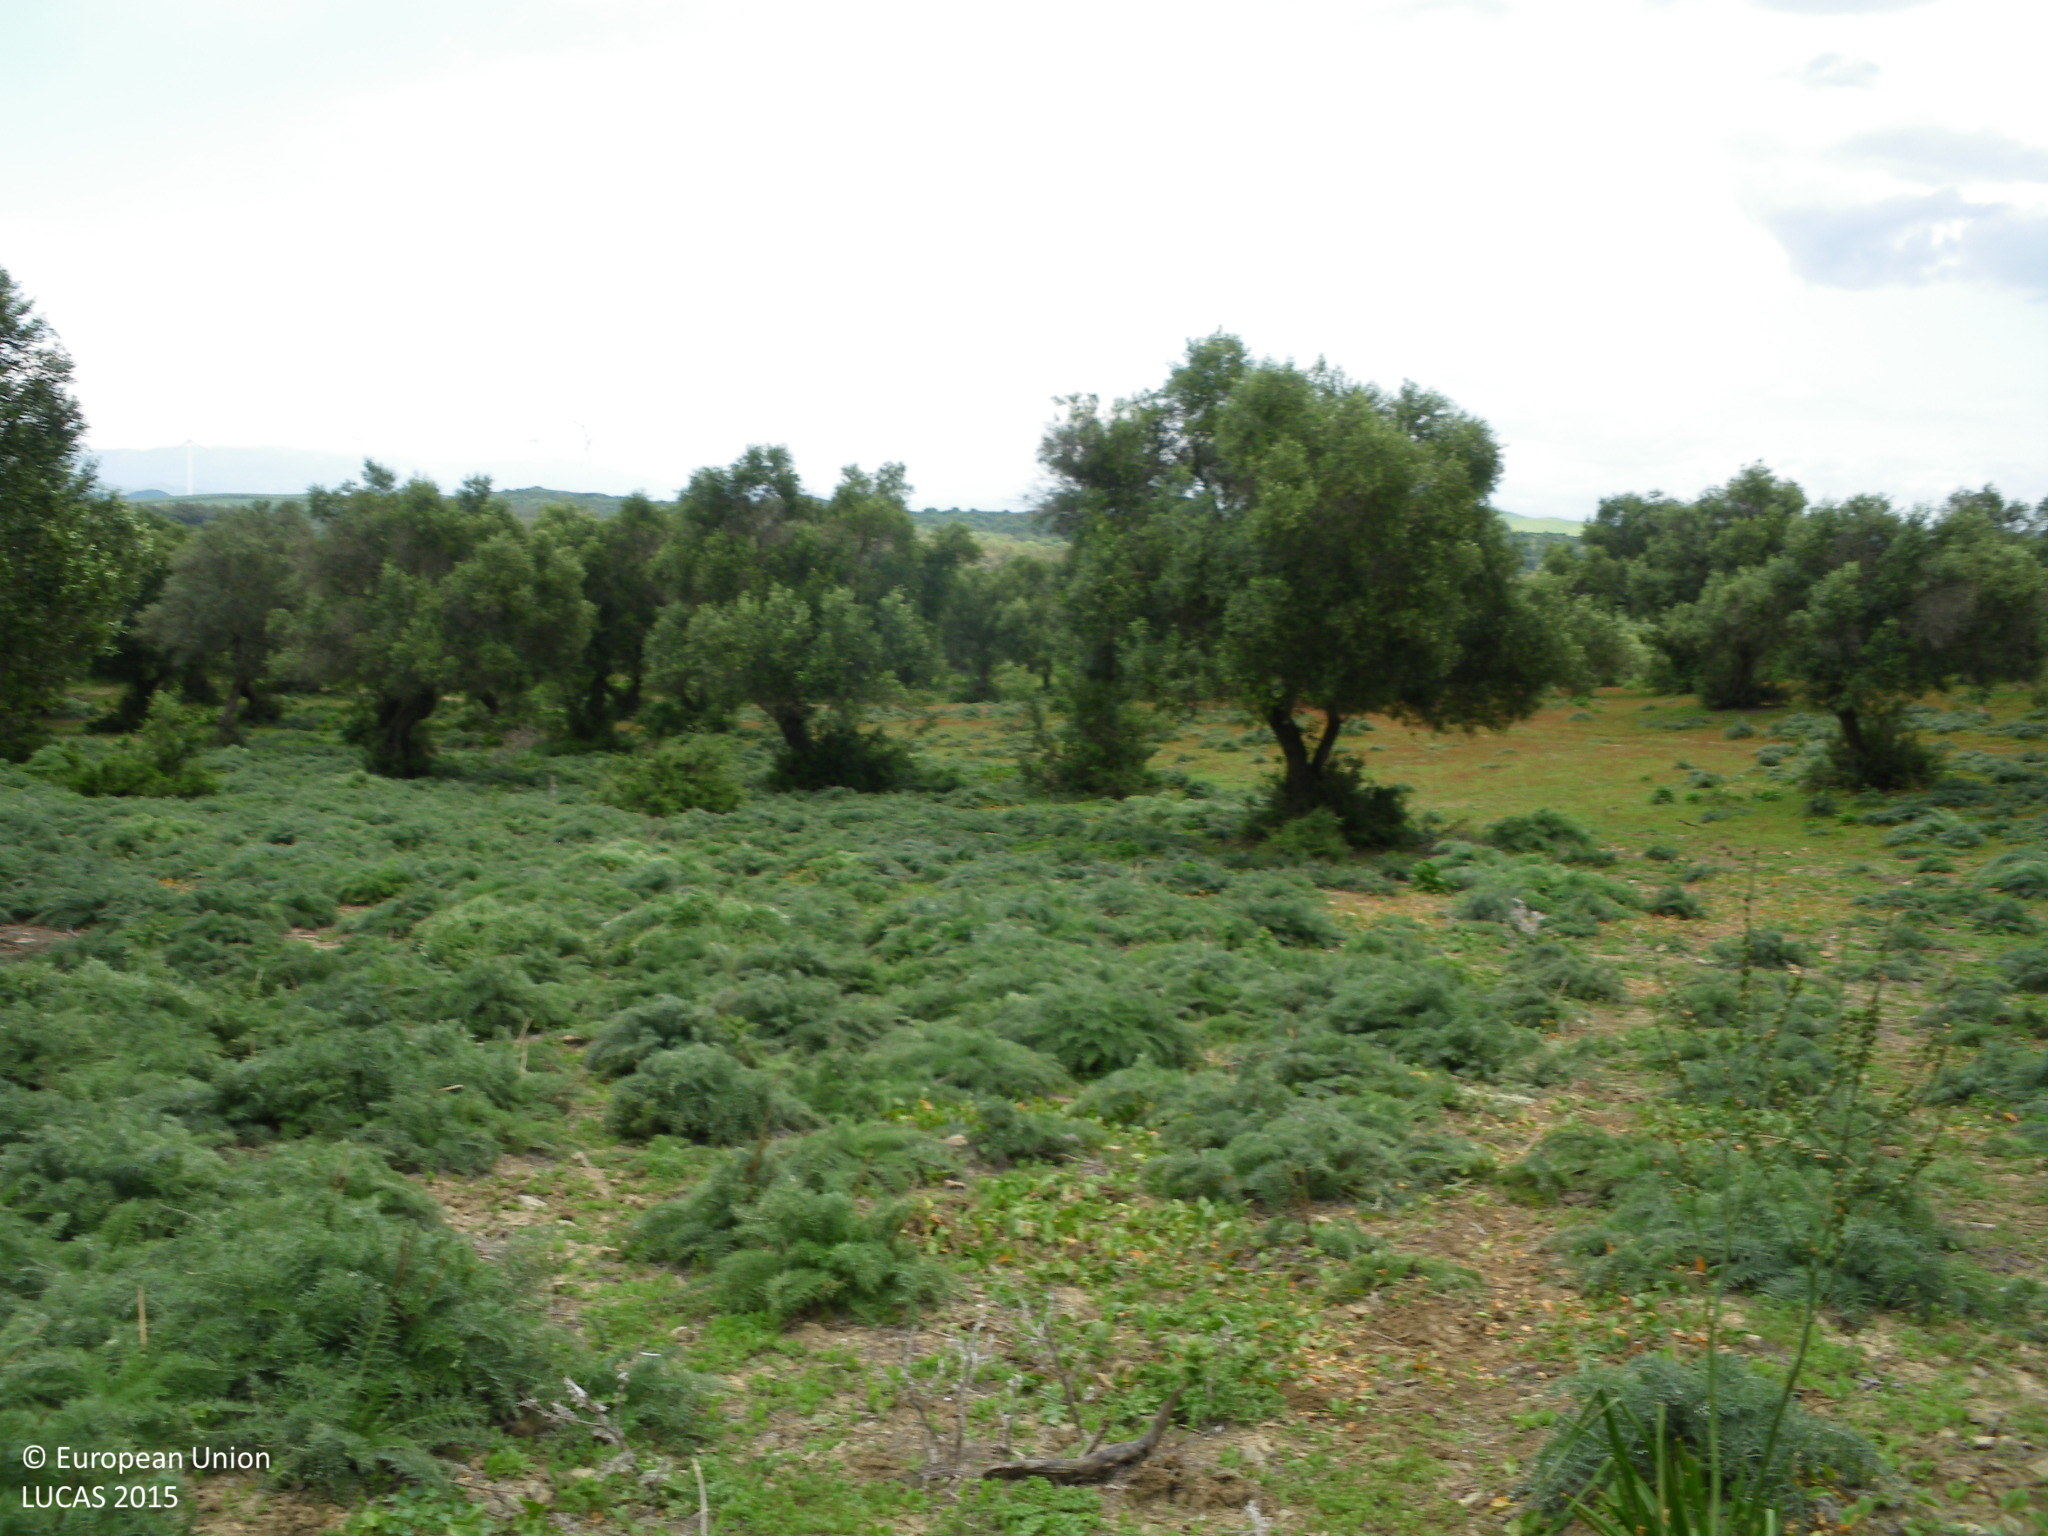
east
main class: Cropland
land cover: Olive groves
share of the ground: 25 - 50 %
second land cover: Spontaneously vegetated surfaces
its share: > 75 %
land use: Agriculture (excluding fallow land and kitchen gardens)
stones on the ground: 10 - 25 %
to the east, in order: Olive groves; Spontaneously vegetated surfaces; Tracks; Olive groves; Other structural elements; Olive groves; Grassland without tree/shrub cover
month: April
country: ES
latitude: 36.4551
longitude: -5.9040
